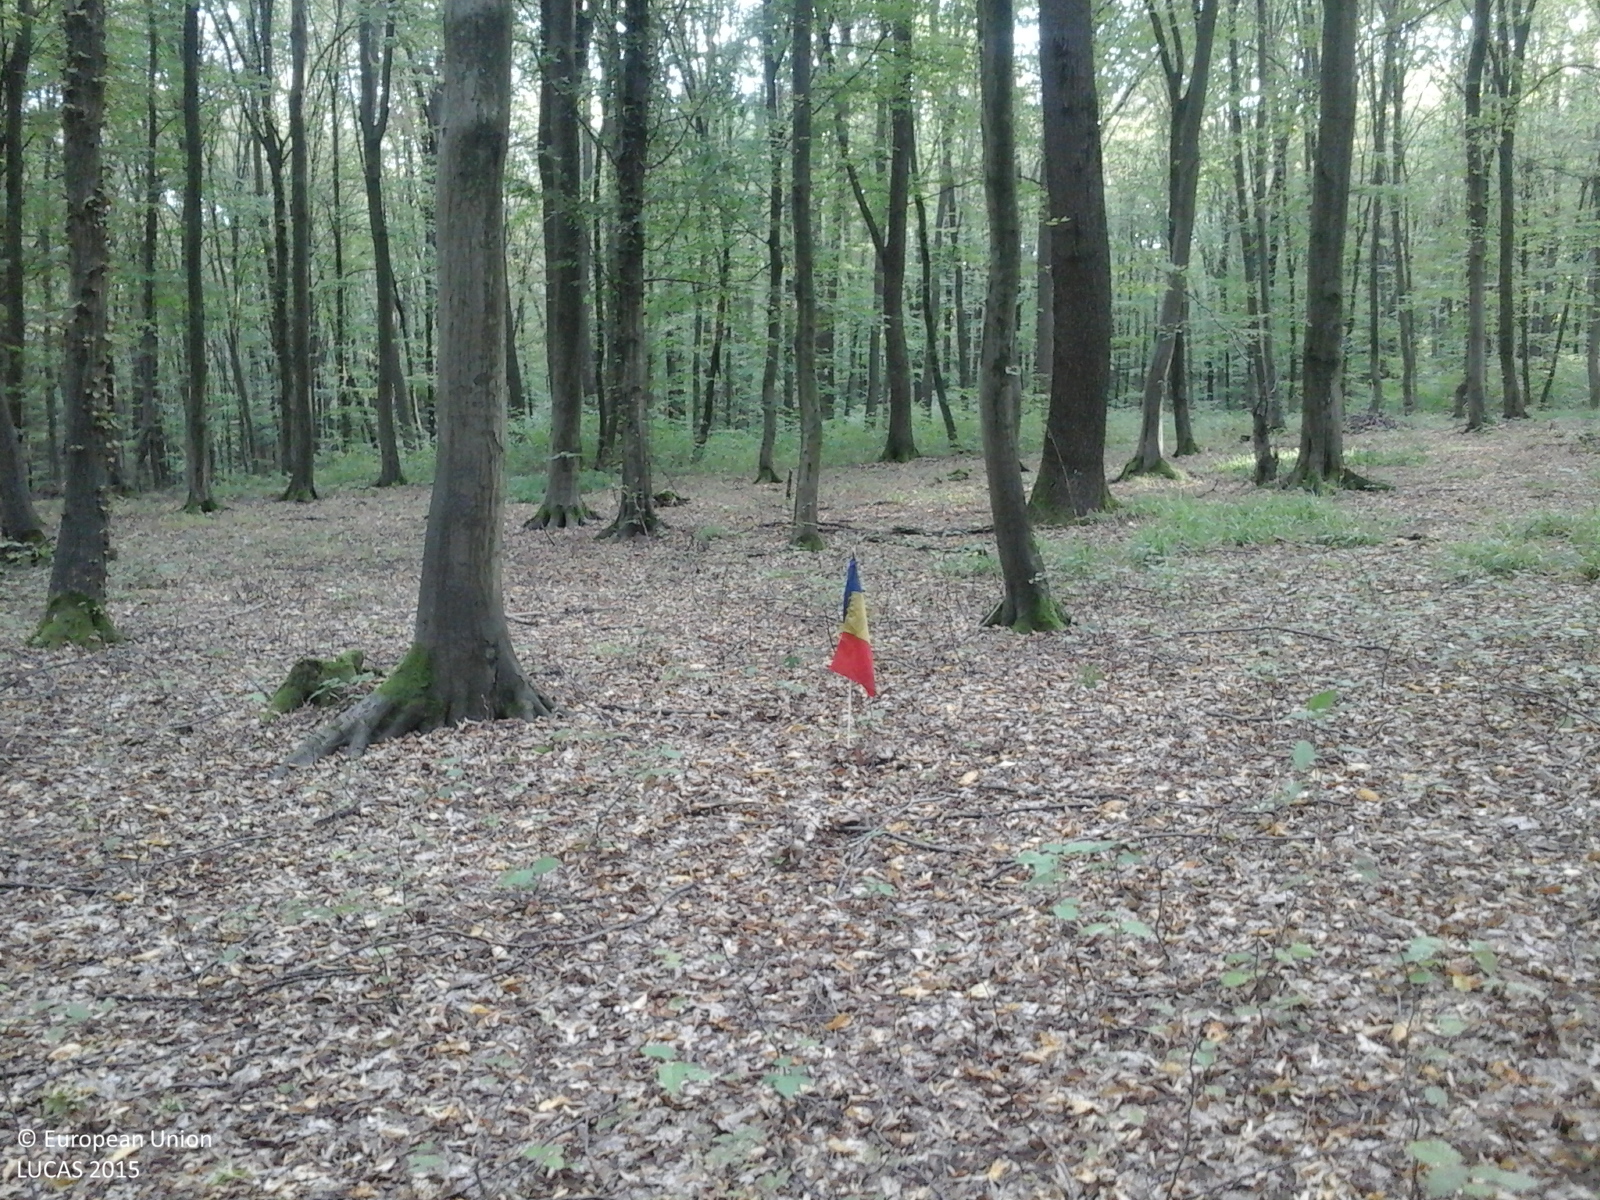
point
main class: Woodland
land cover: Broadleaved woodland
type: beech forest
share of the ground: > 75 %
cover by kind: broadleaved forest trees 100 %
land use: Forestry
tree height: > 5 m
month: September
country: RO
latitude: 47.6240
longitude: 23.3653
